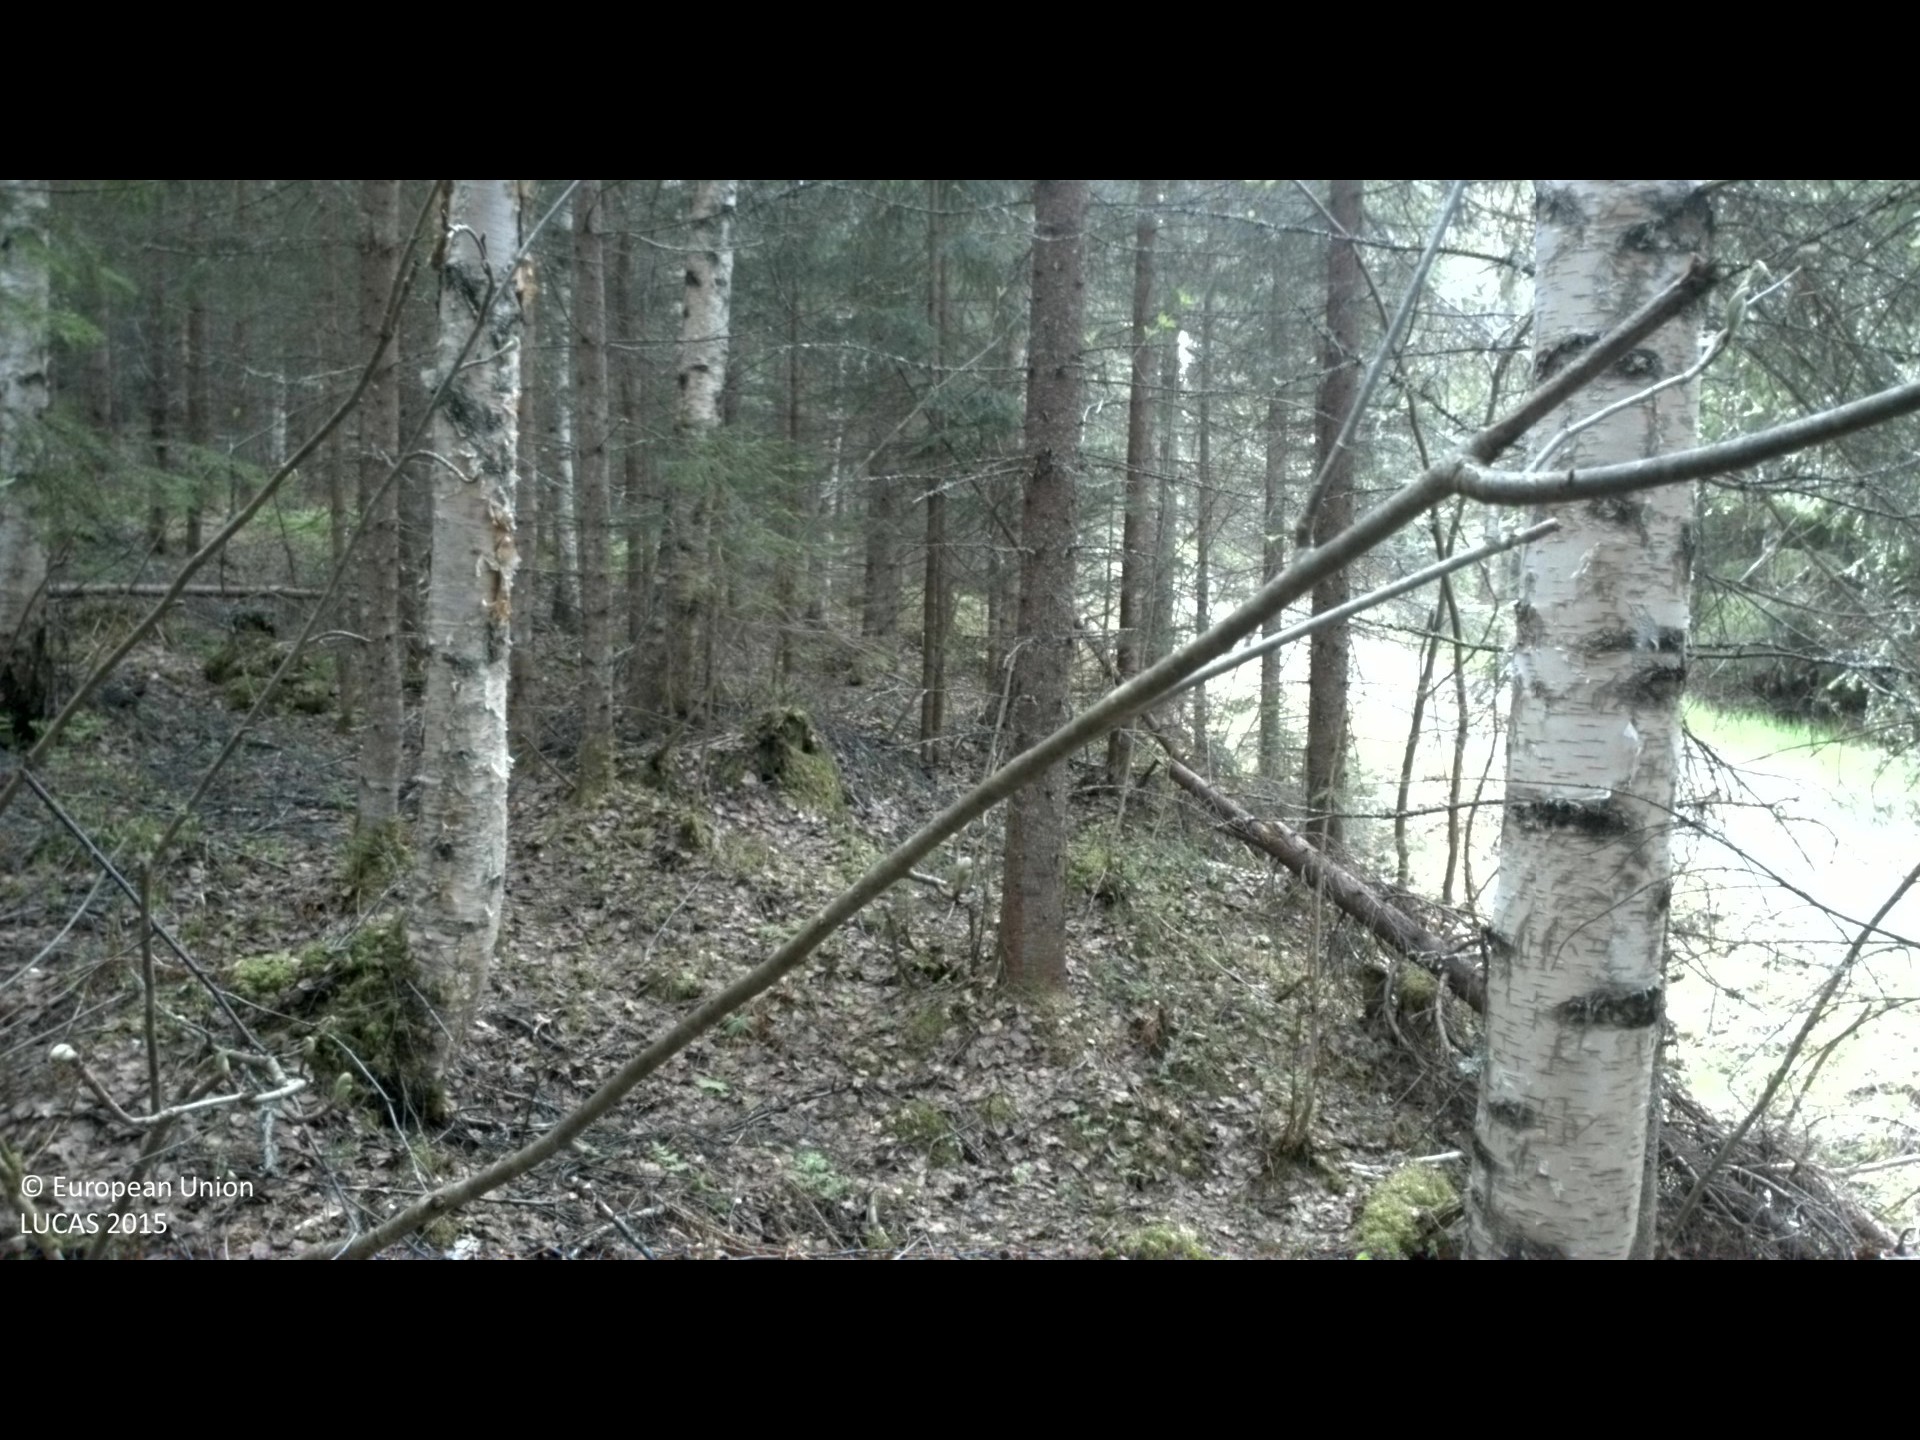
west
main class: Woodland
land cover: Spruce dominated mixed woodland
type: boreal forest
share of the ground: 50 - 75 %
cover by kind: coniferous forest trees 40 %, broadleaved forest trees 20 %
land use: Forestry
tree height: > 5 m
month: May
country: SE
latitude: 63.0328
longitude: 17.3098
